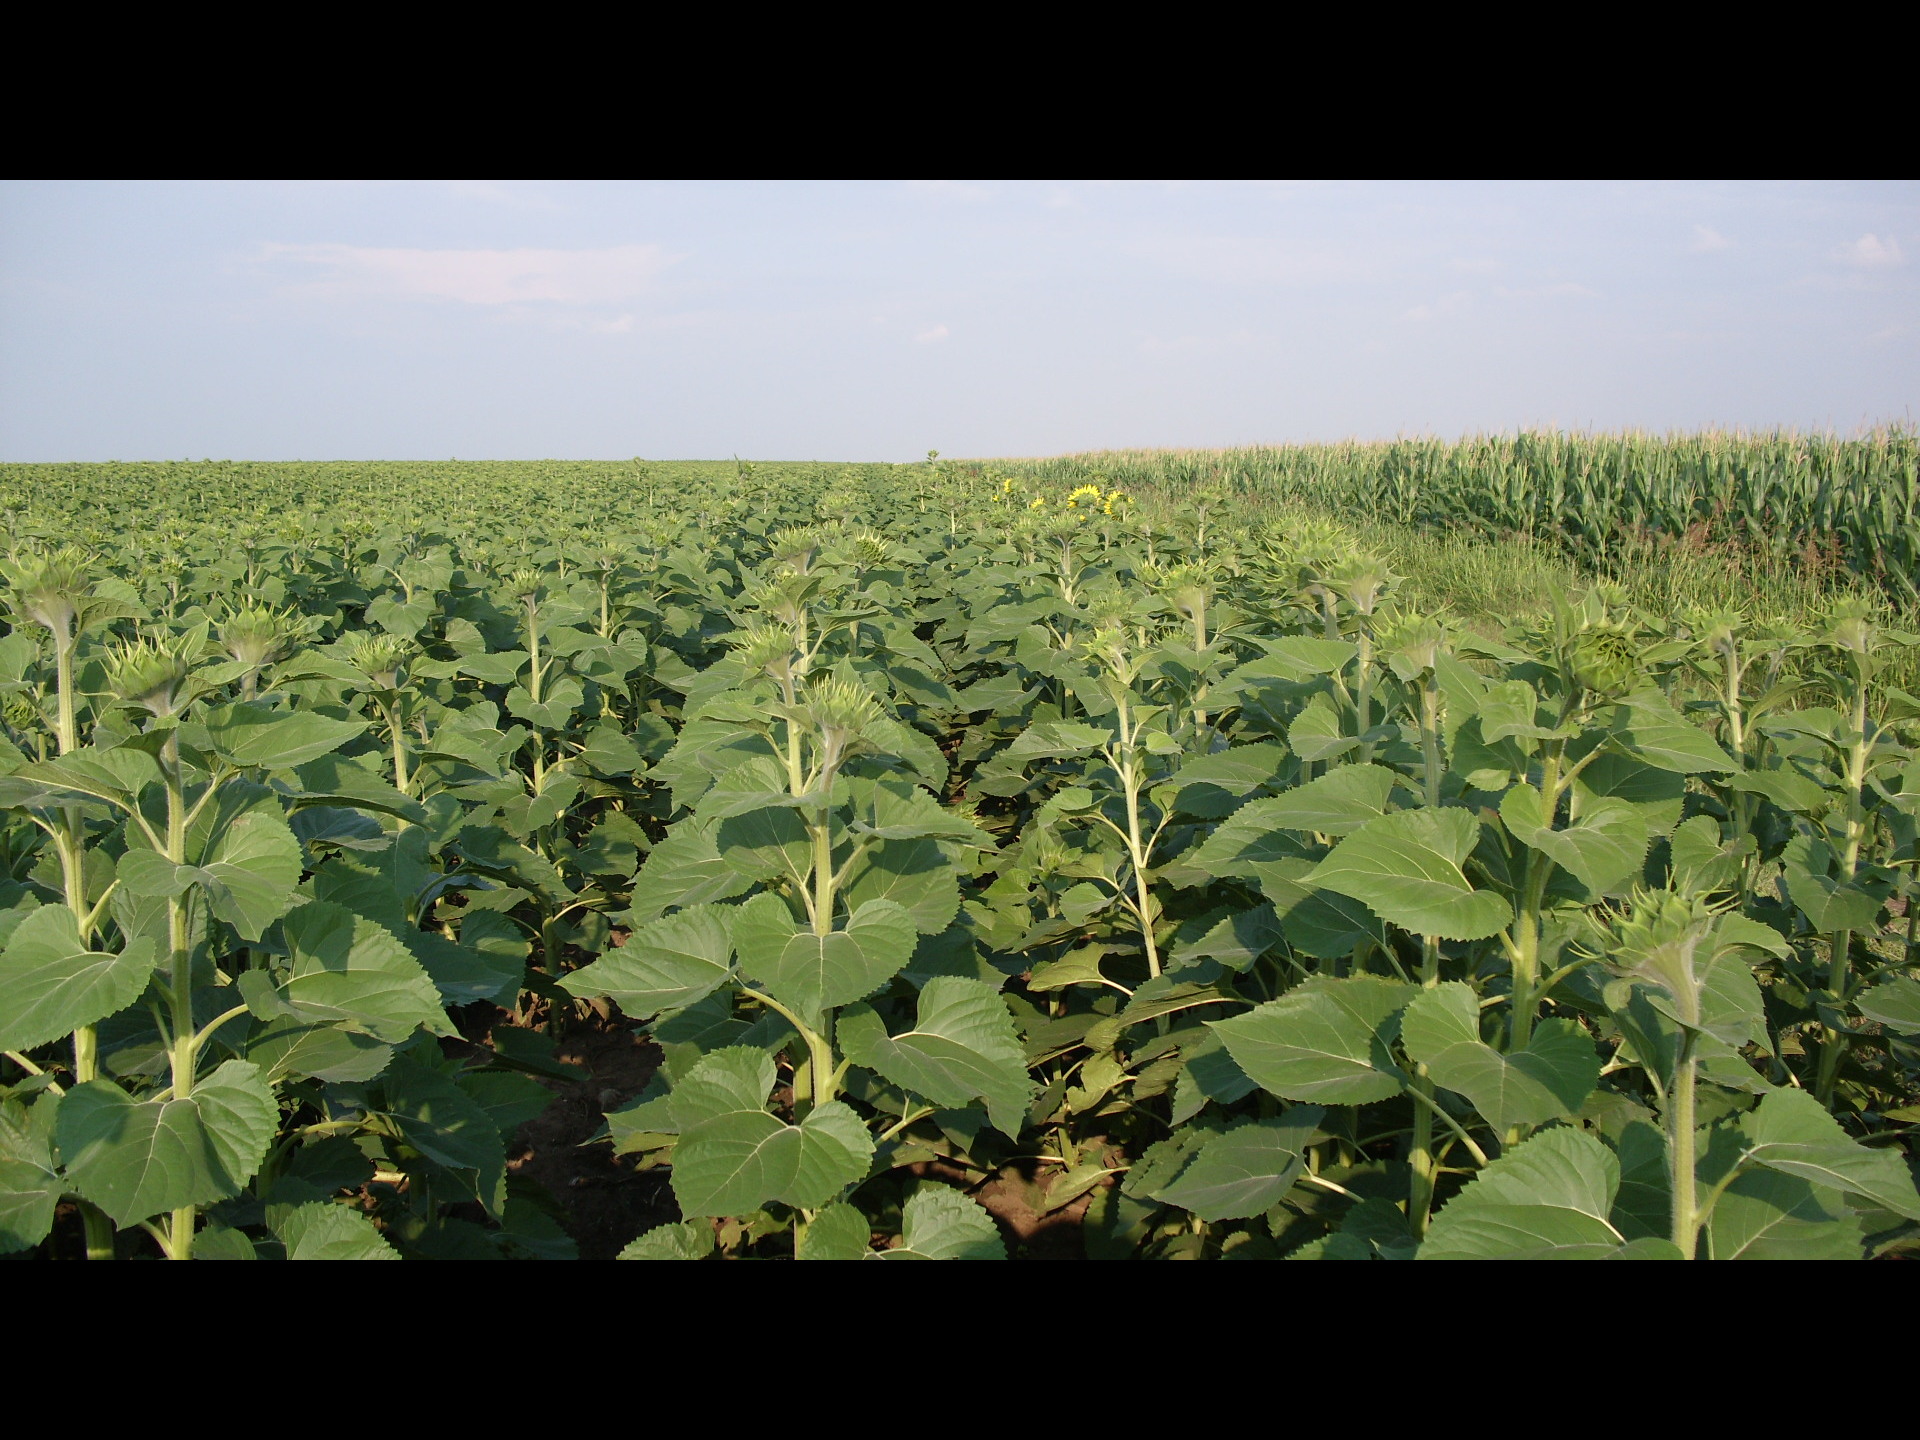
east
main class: Cropland
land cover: Sunflower
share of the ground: > 75 %
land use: Agriculture (excluding fallow land and kitchen gardens)
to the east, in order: Sunflower
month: June
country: BG
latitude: 43.6902
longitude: 23.5832
